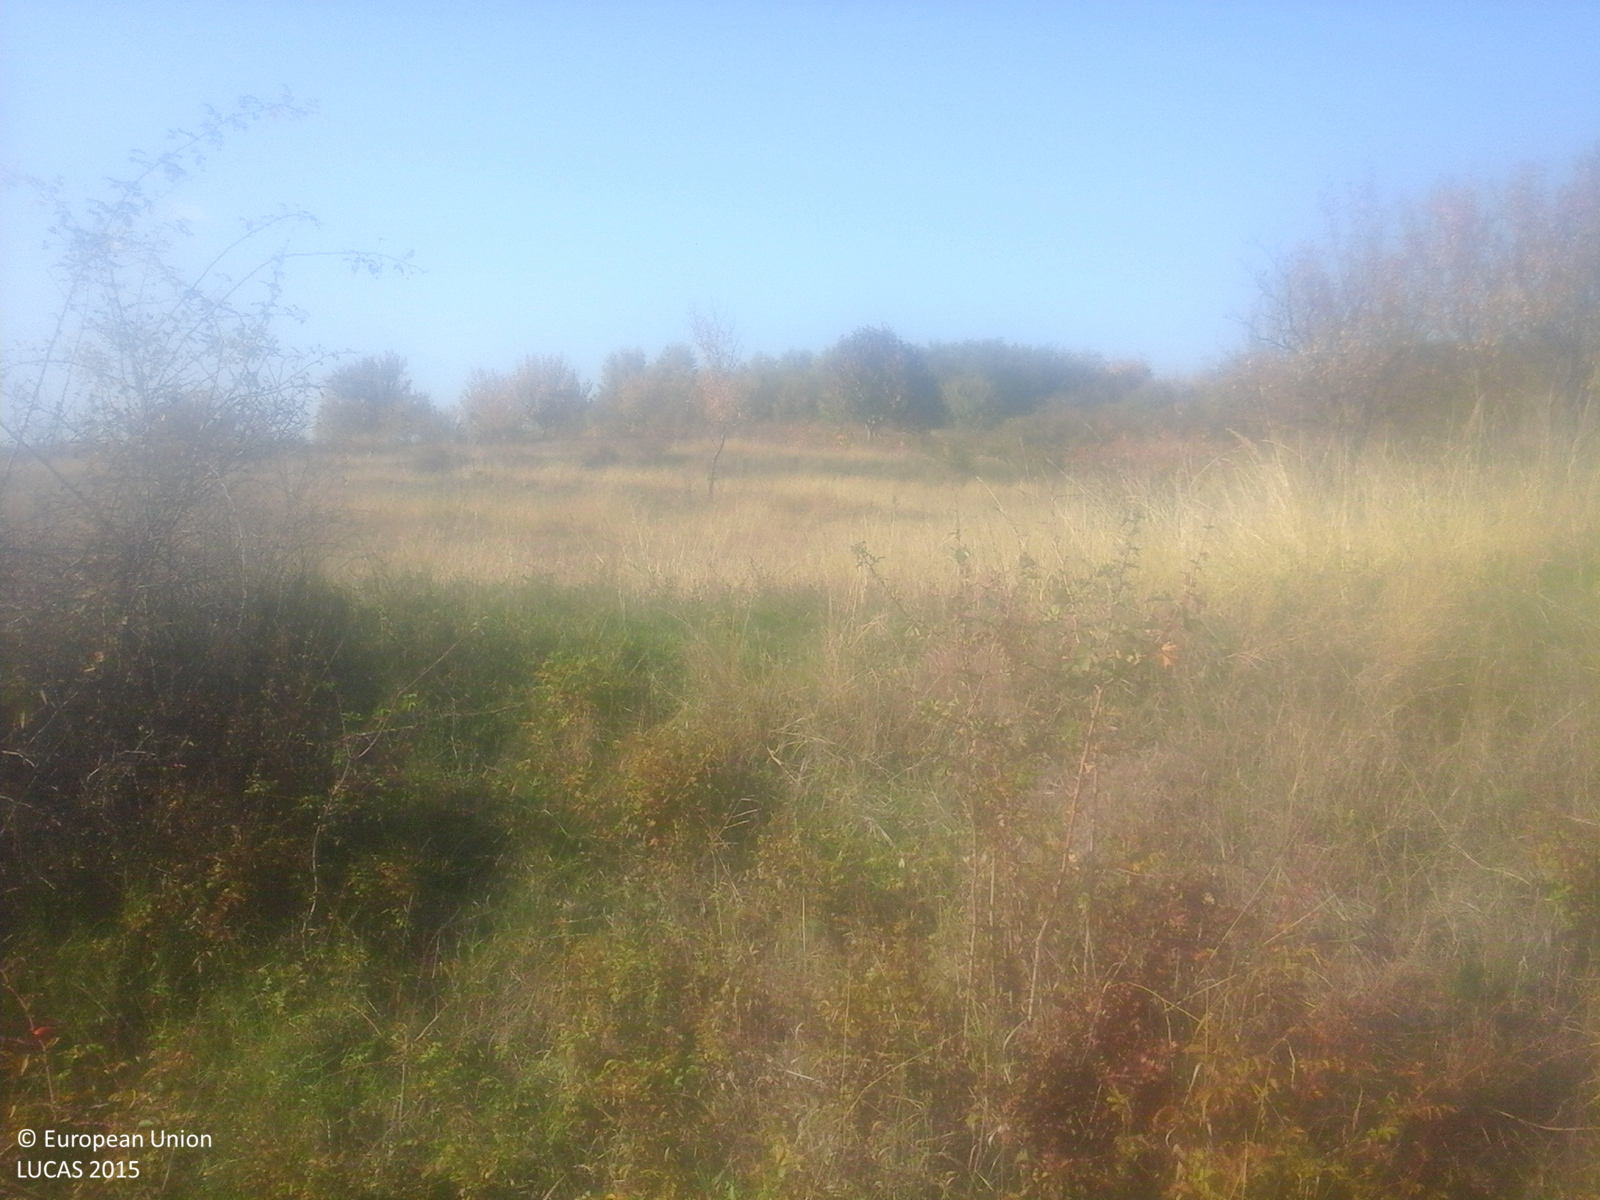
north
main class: Grassland
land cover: Grassland with sparse tree/shrub cover
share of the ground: > 75 %
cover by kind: herbaceous plants 85 %, shrubs 10 %, broadleaved forest trees 5 %
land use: Agriculture (excluding fallow land and kitchen gardens)
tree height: < 5 m
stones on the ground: < 10 %
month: October
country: RO
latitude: 45.3312
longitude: 26.8614
